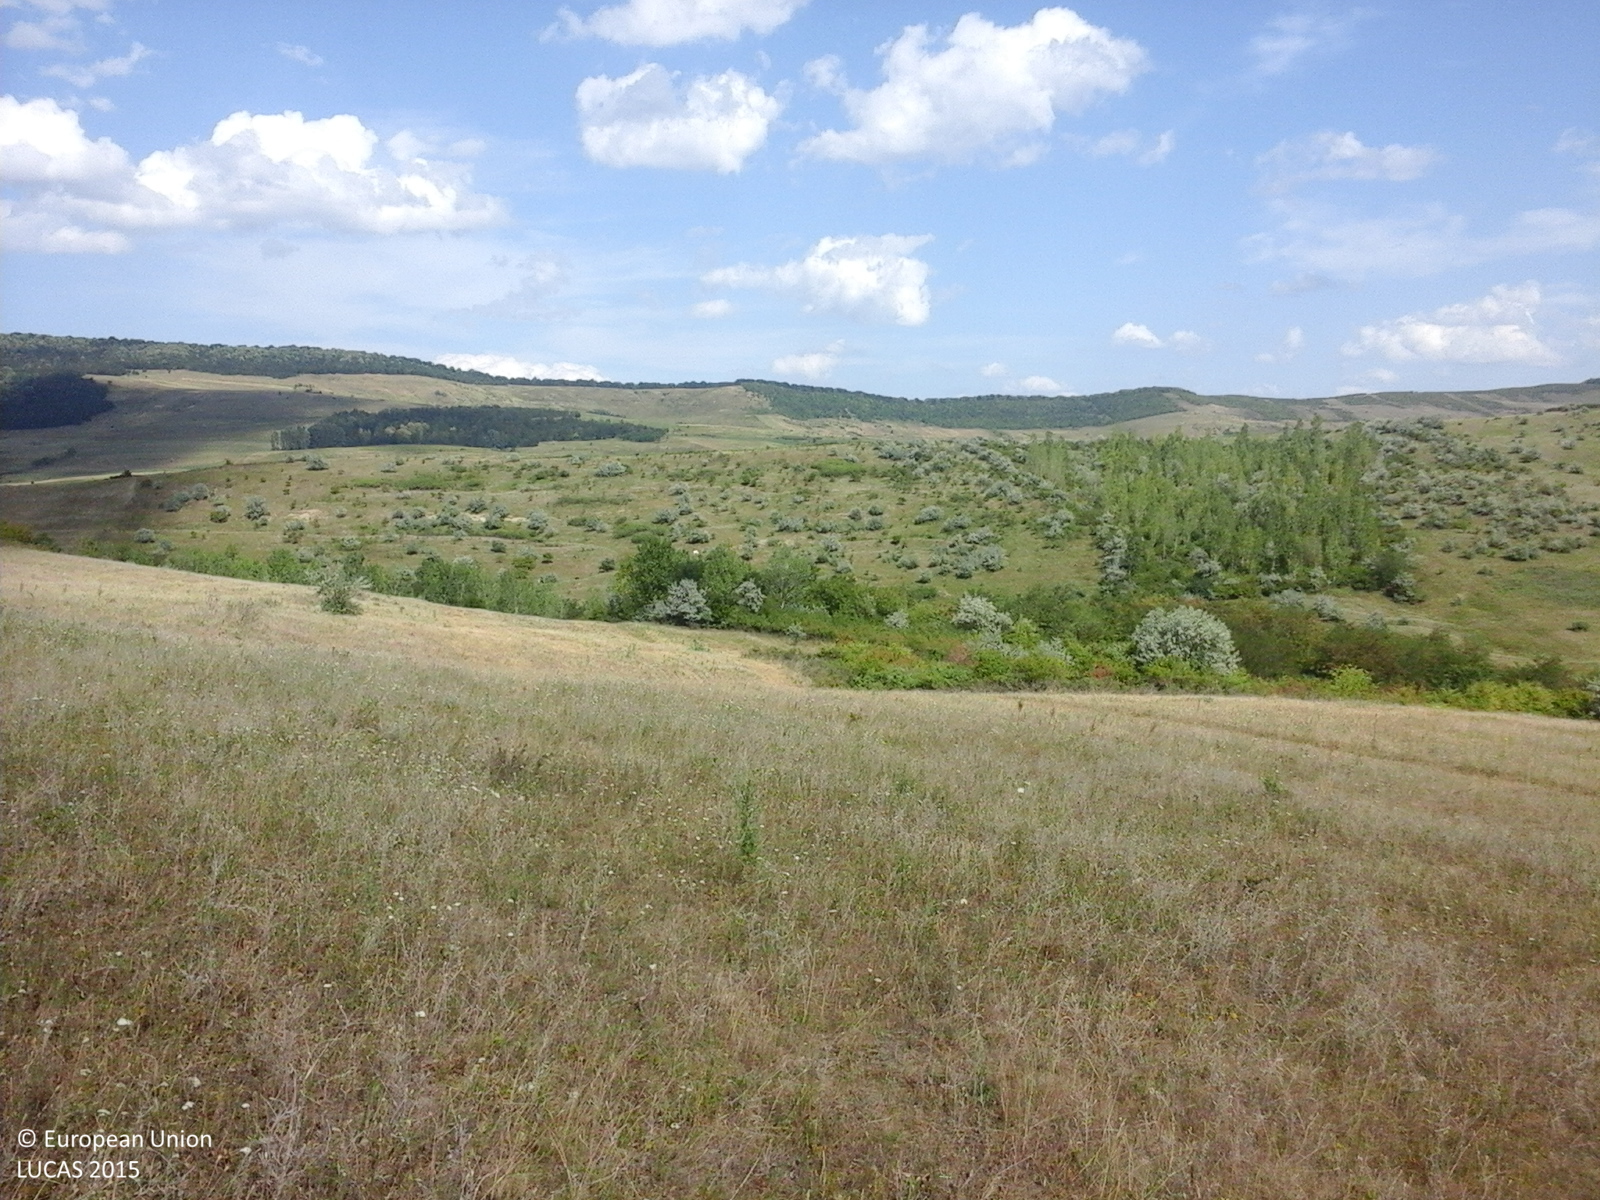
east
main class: Grassland
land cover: Grassland without tree/shrub cover
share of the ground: > 75 %
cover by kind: herbaceous plants 100 %
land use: Agriculture (excluding fallow land and kitchen gardens)
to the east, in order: Grassland without tree/shrub cover; Tracks; Shrubland with sparse tree cover; Grassland without tree/shrub cover; Single bushes/trees; Shrubland with sparse tree cover; Broadleaved woodland
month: July
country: RO
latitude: 46.6076
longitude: 27.3810
